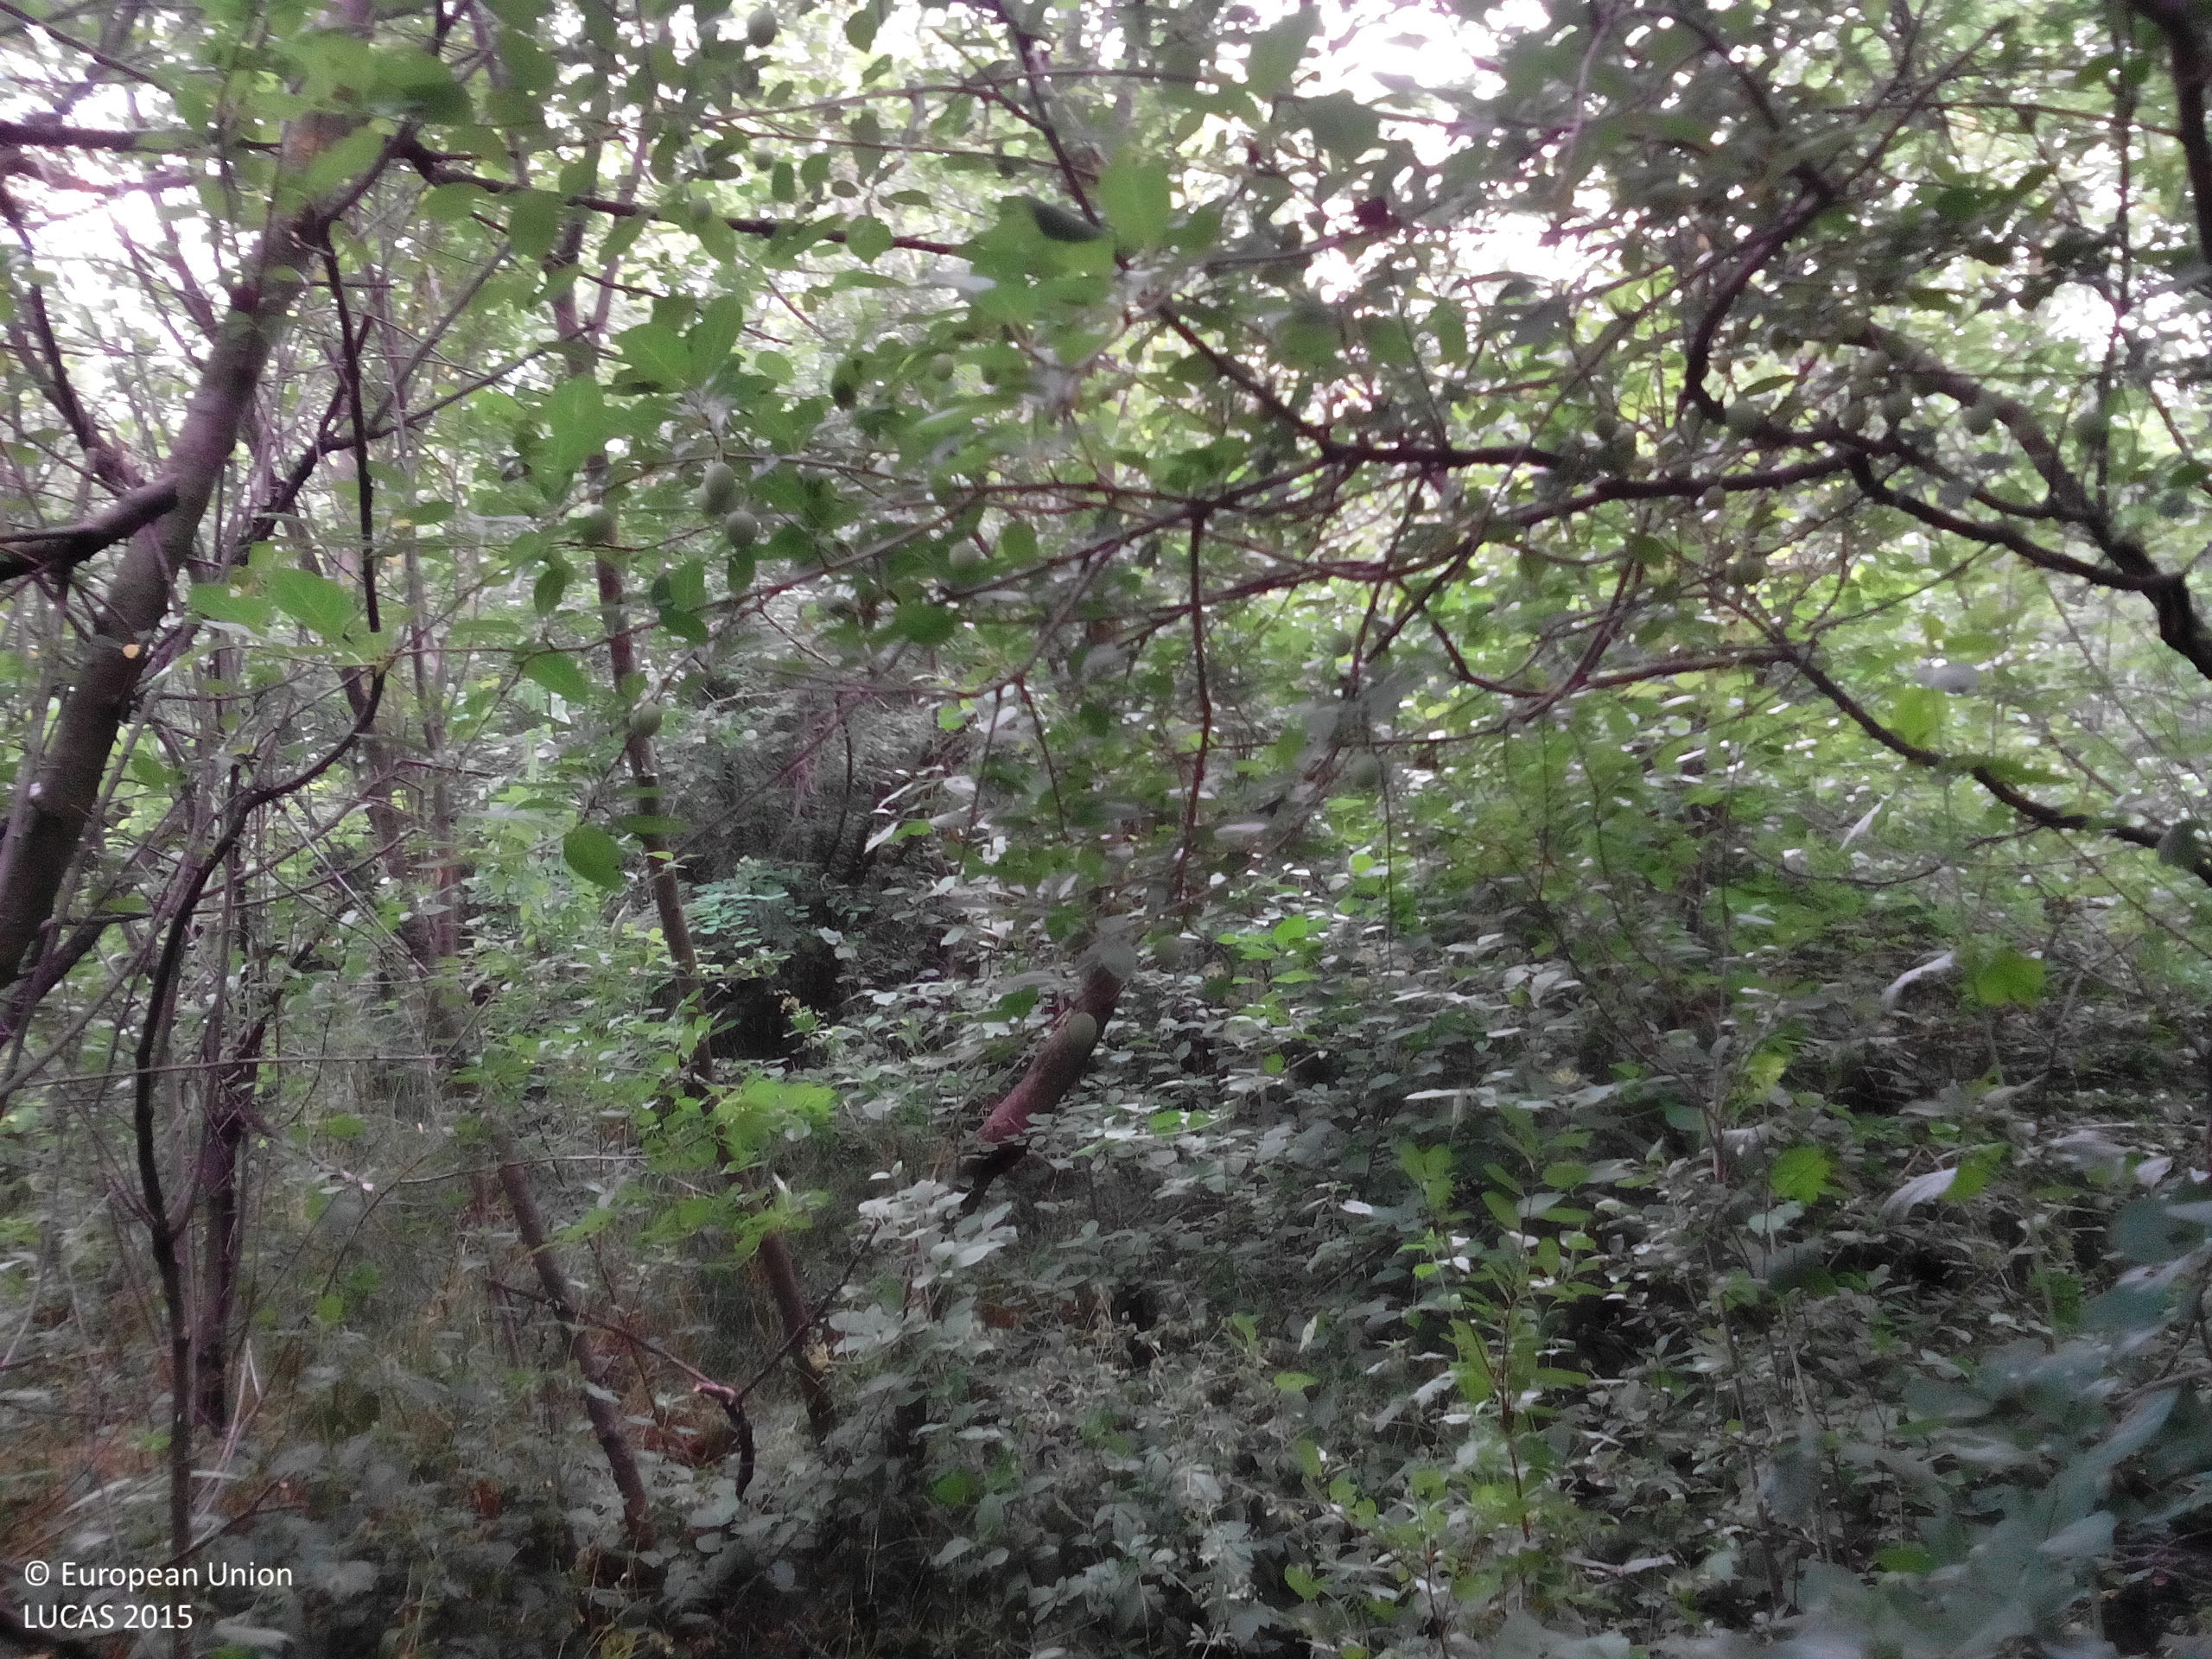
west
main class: Woodland
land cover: Broadleaved woodland
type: mesophytic deciduous forest
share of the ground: > 75 %
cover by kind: broadleaved forest trees 80 %, shrubs 15 %, herbaceous plants 5 %
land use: Semi-natural and natural areas not in use
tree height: > 5 m
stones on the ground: < 10 %
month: May
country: BG
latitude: 43.5471
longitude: 24.2290
